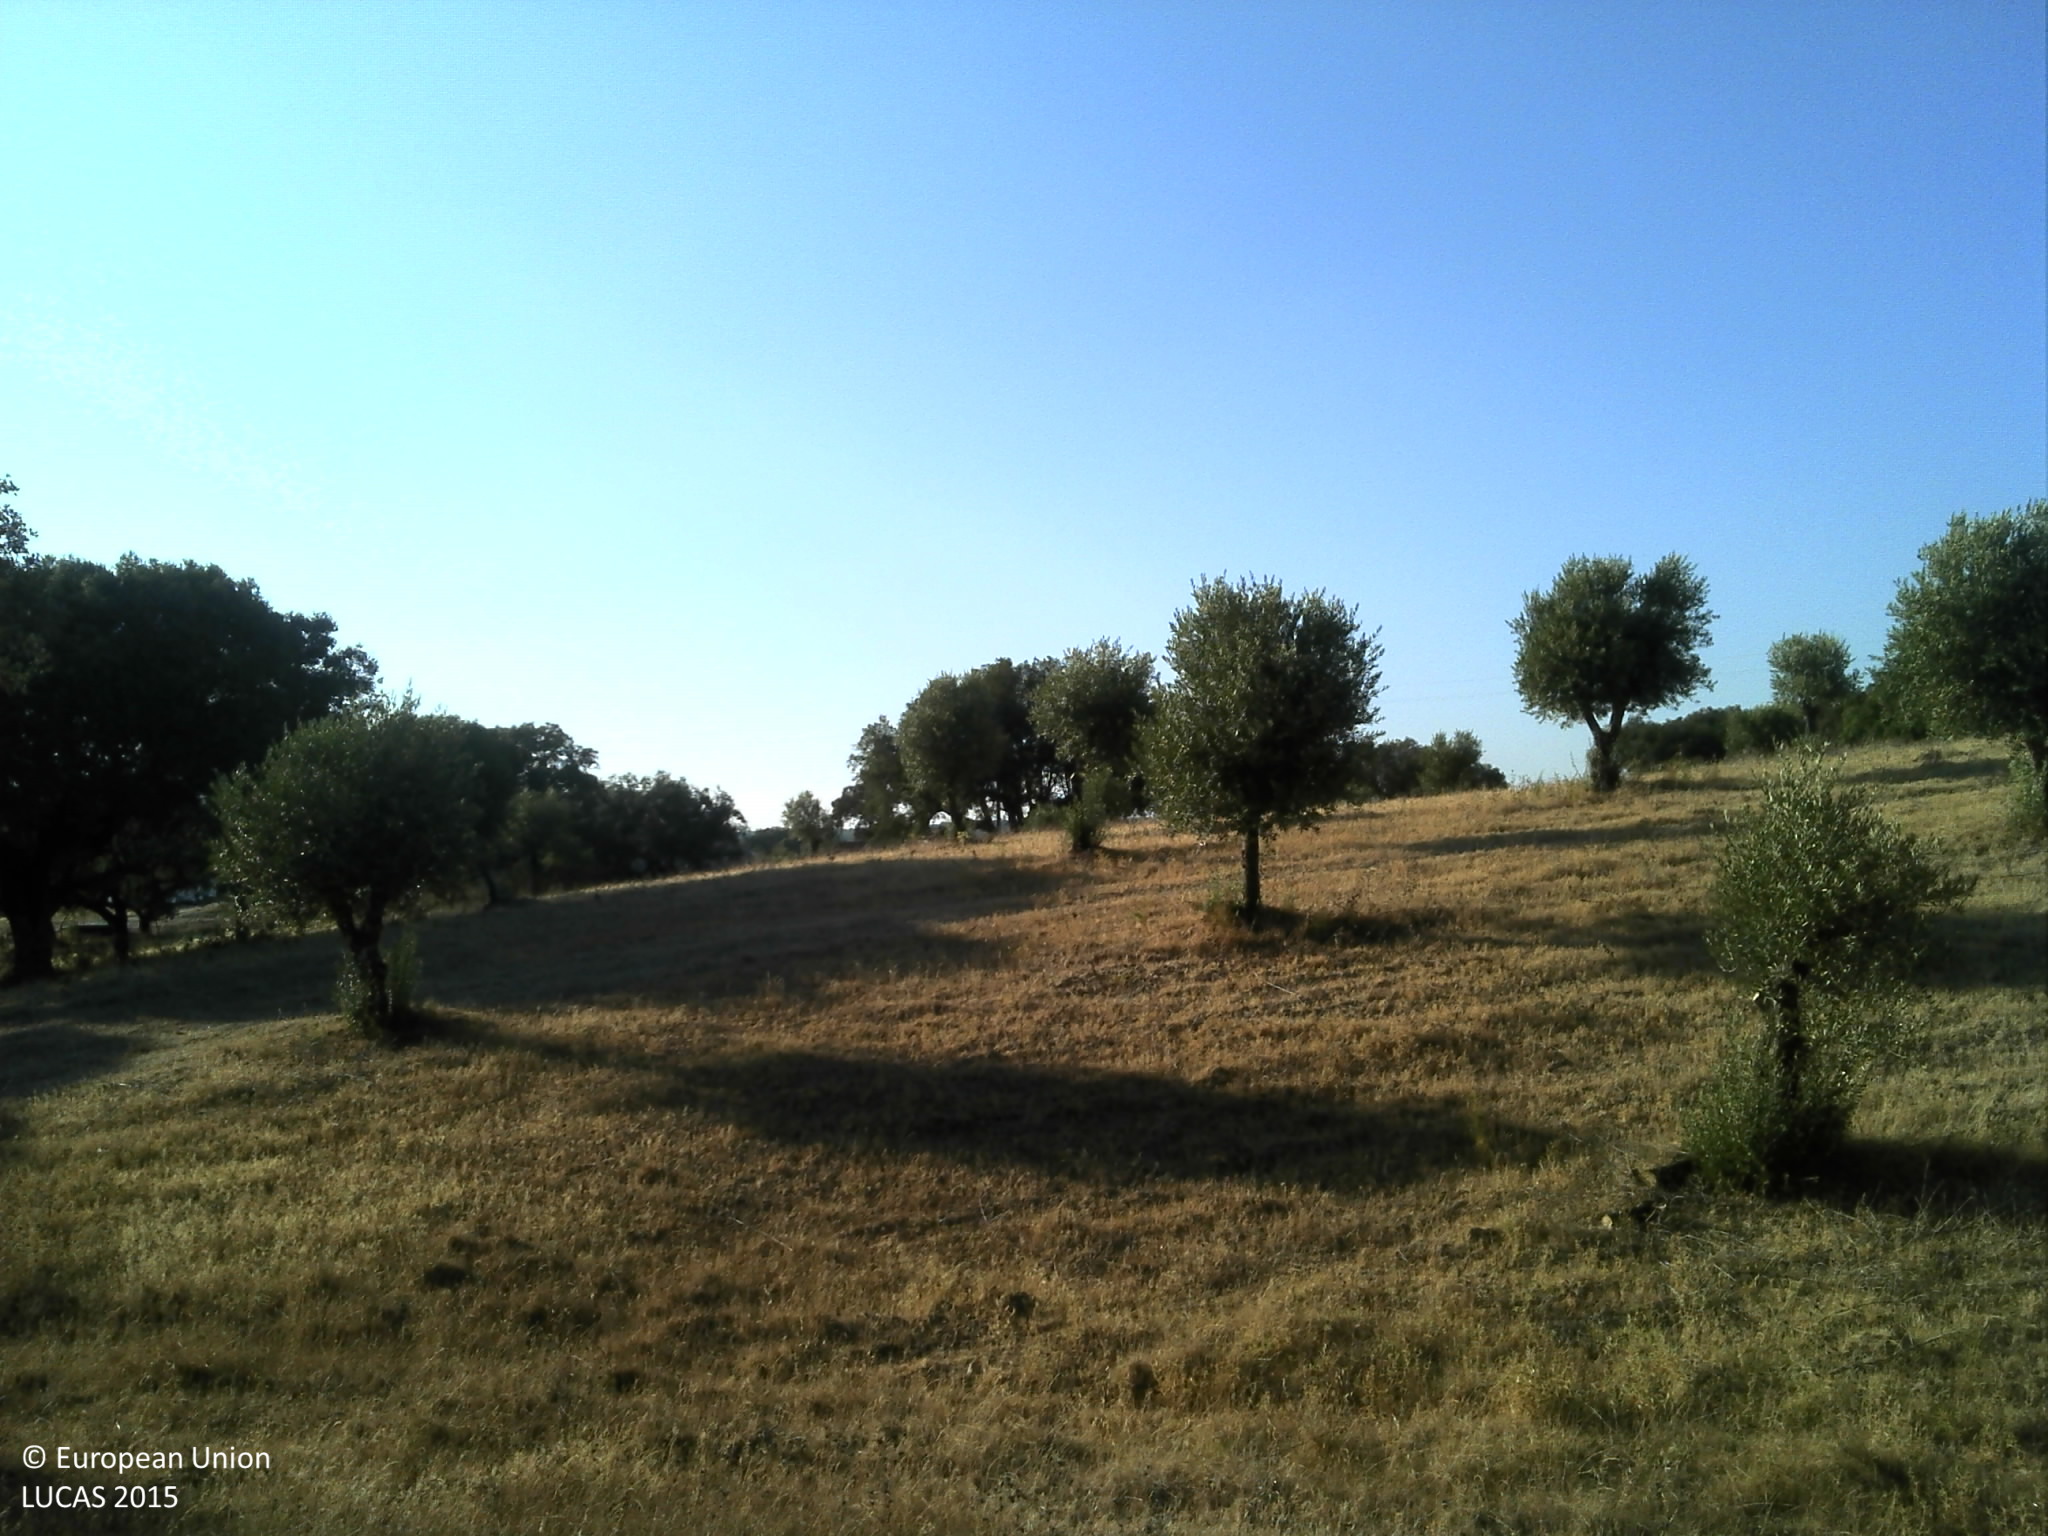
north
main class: Cropland
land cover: Olive groves
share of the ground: 25 - 50 %
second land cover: Grassland without tree/shrub cover
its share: 50 - 75 %
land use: Agriculture (excluding fallow land and kitchen gardens)
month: July
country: PT
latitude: 38.8668
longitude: -8.1810
